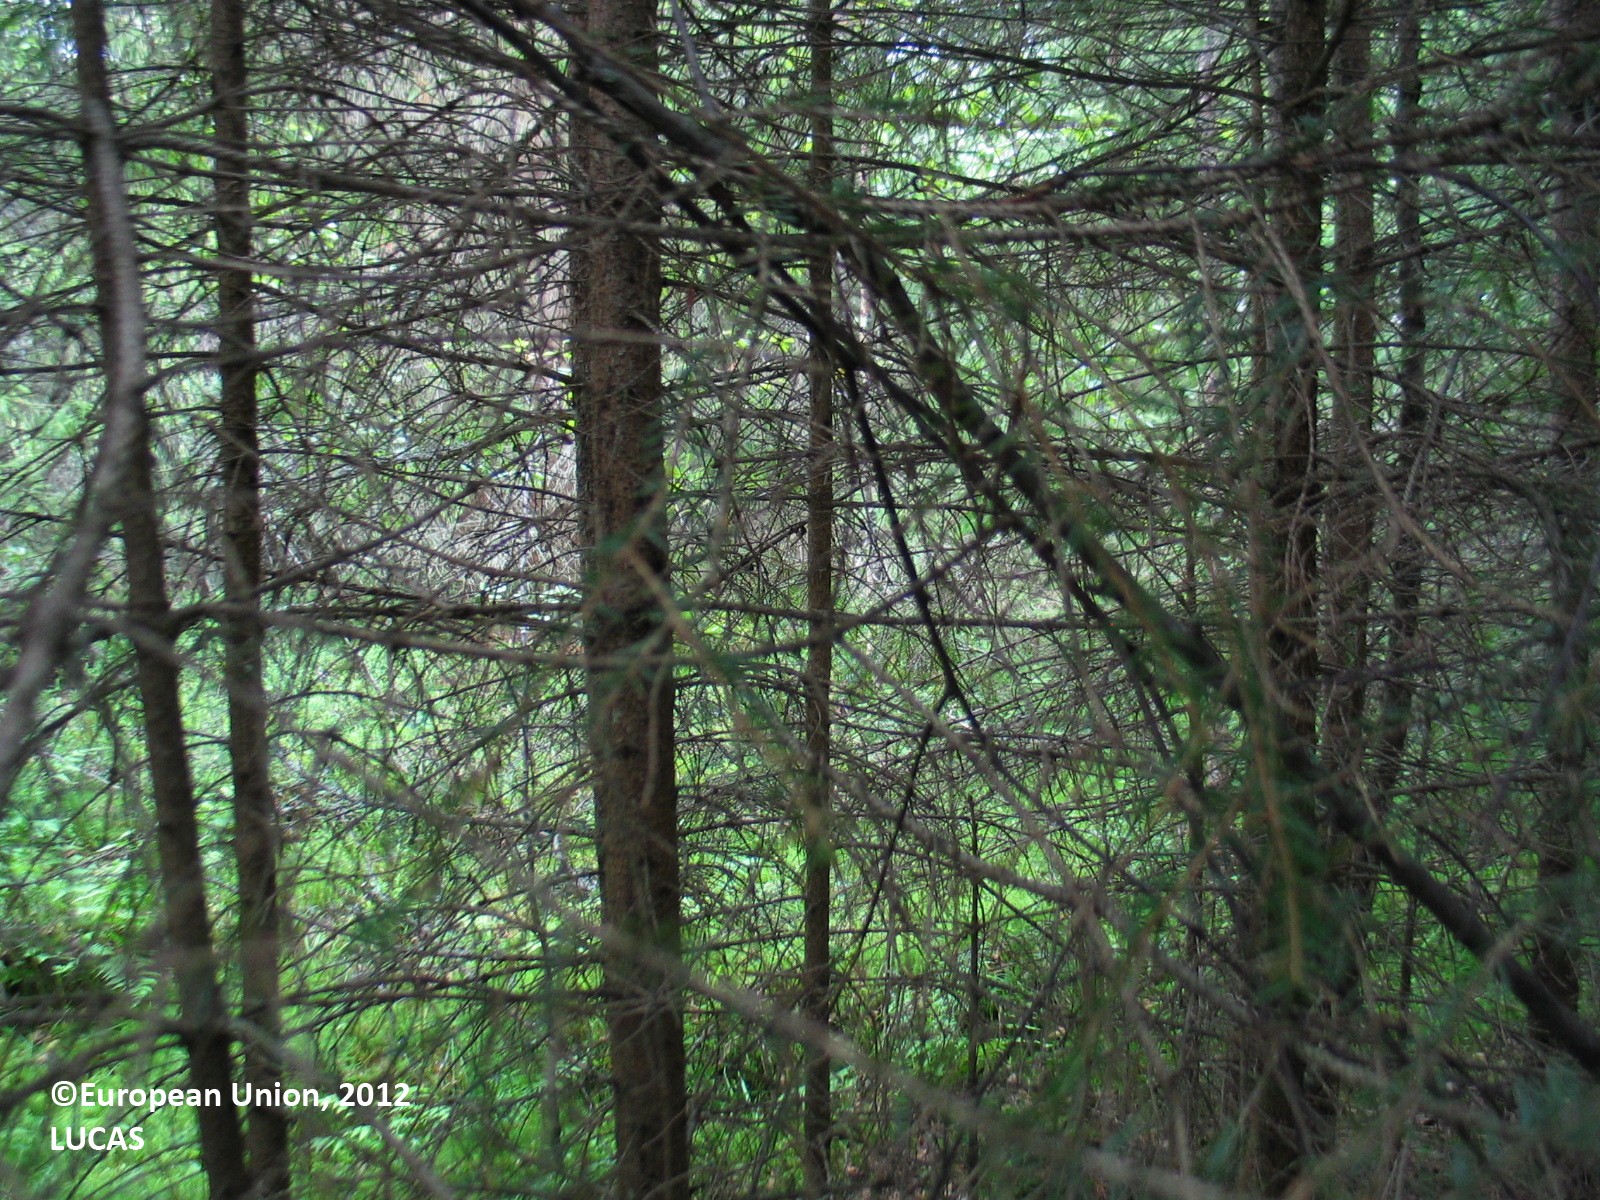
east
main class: Woodland
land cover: Other mixed woodland
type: mire and swamp forests
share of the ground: 50 - 75 %
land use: Forestry
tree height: > 5 m
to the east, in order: Other mixed woodland; Ditches and canals; Other mixed woodland; Shrubland without tree cover; Other mixed woodland; Tracks; Abandoned hedges; Ditches and canals; Pine dominated mixed woodland; Tracks; Pine dominated mixed woodland; Ditches and canals; Pine dominated mixed woodland
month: July
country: FI
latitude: 64.5812
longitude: 26.3332
